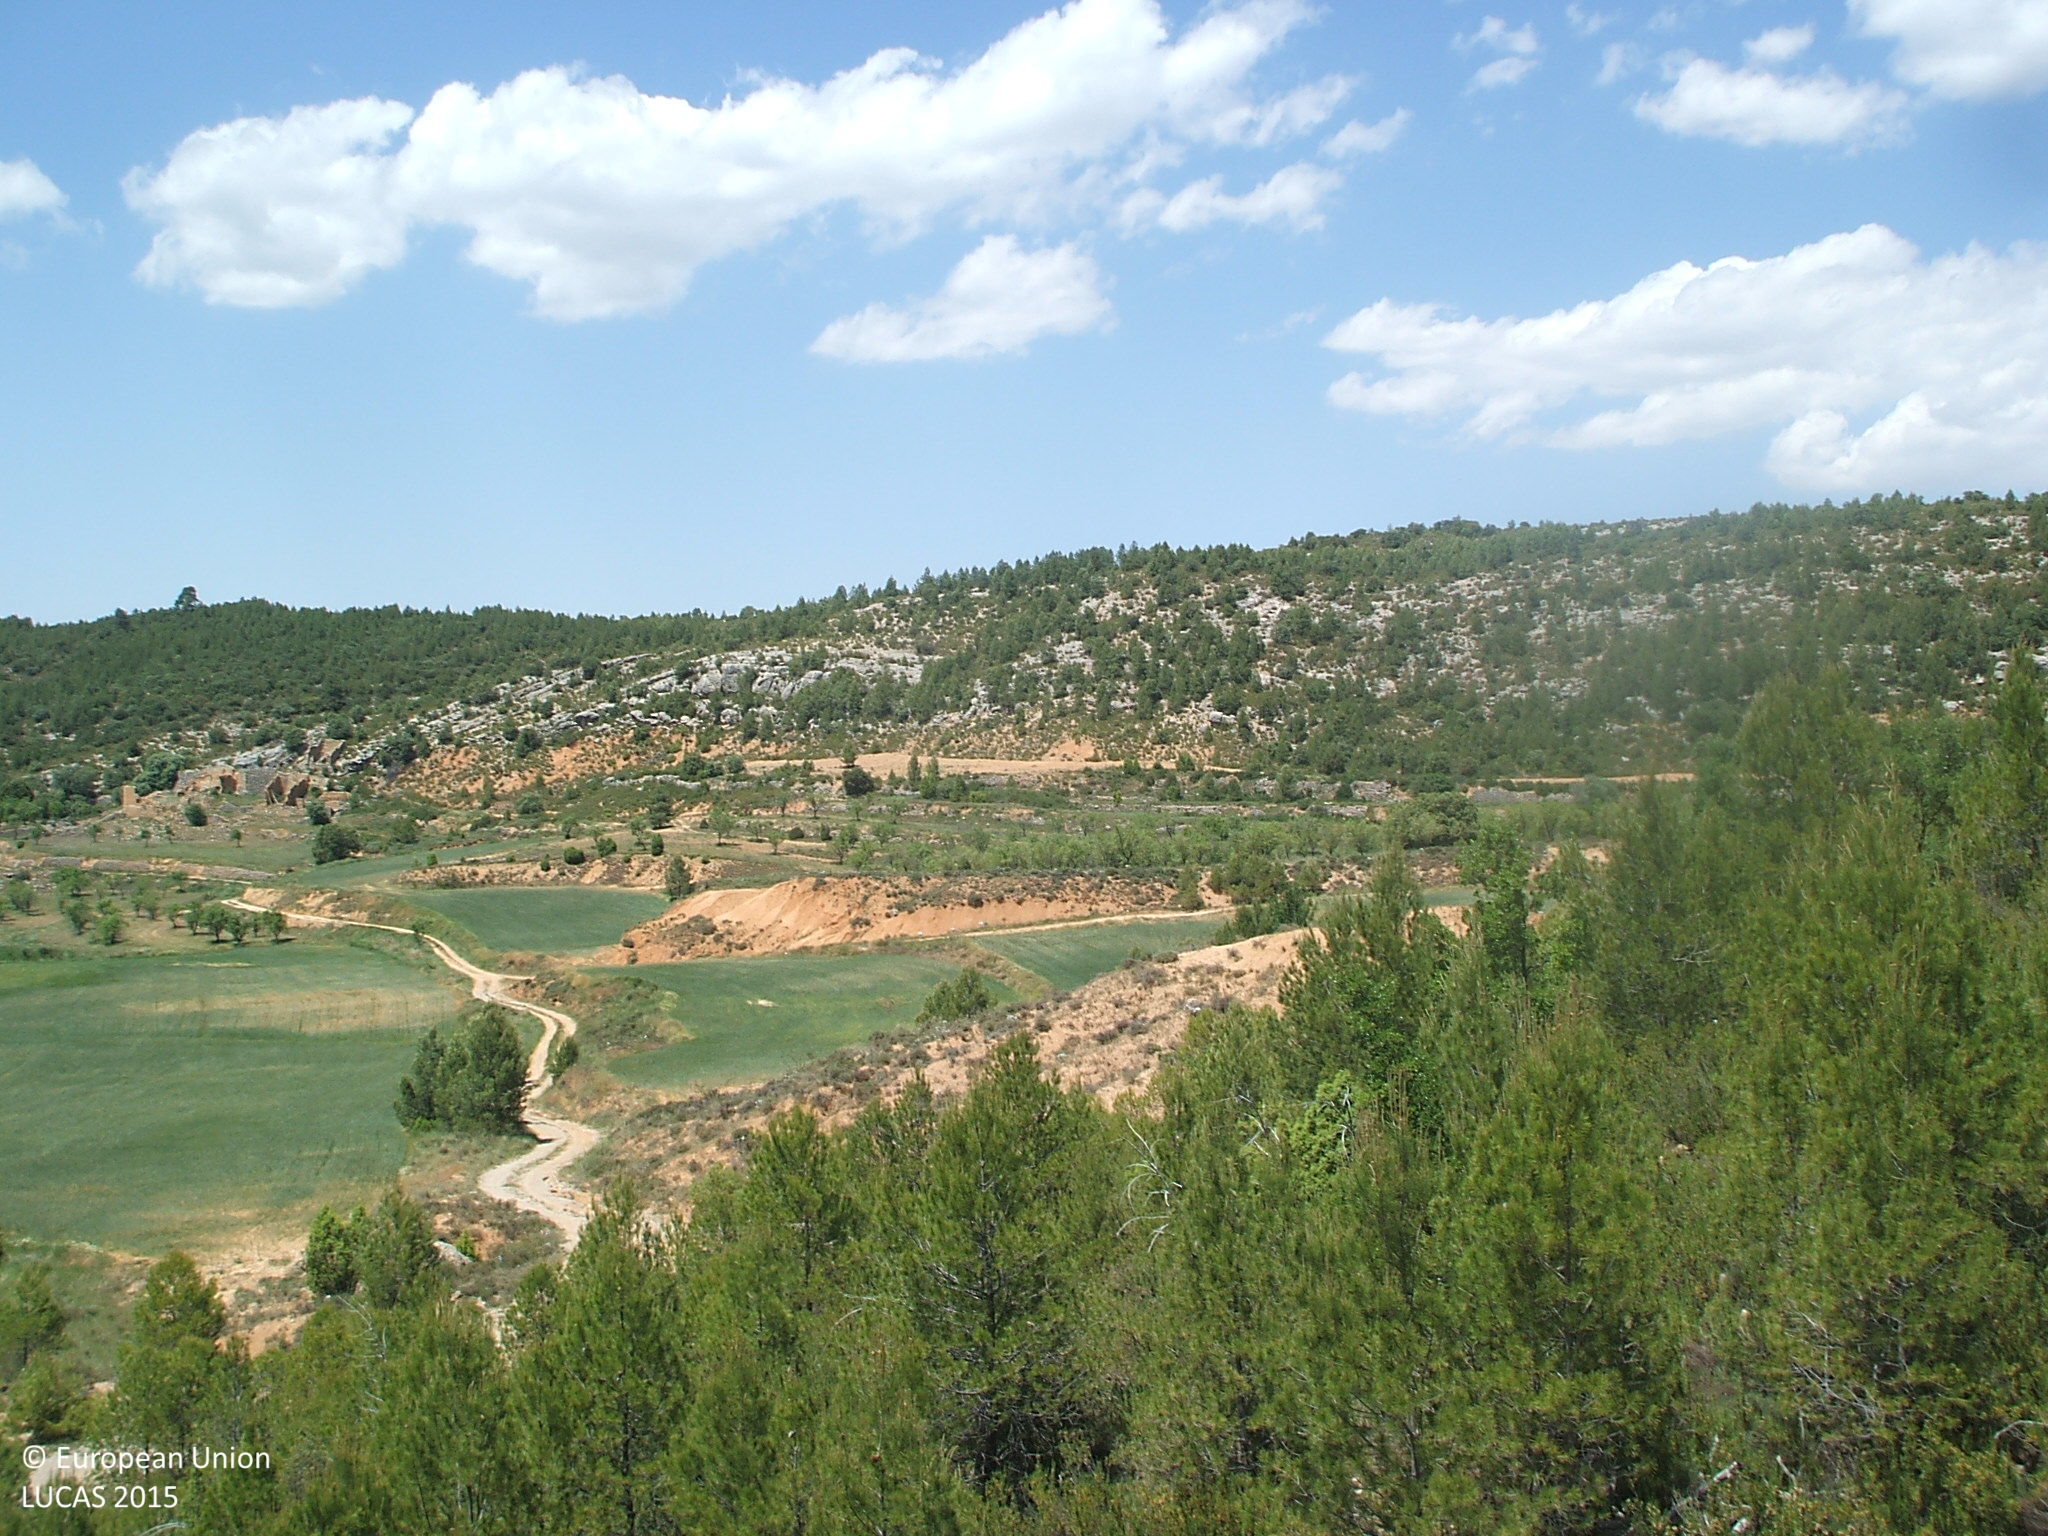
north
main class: Woodland
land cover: Pine dominated coniferous woodland
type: coniferous forest of the mediterranean region
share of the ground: 25 - 50 %
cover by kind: shrubs 50 %, coniferous forest trees 40 %, consolidated bare surface 10 %
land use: Semi-natural and natural areas not in use
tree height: > 5 m
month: May
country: ES
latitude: 40.7049
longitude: -0.1517
